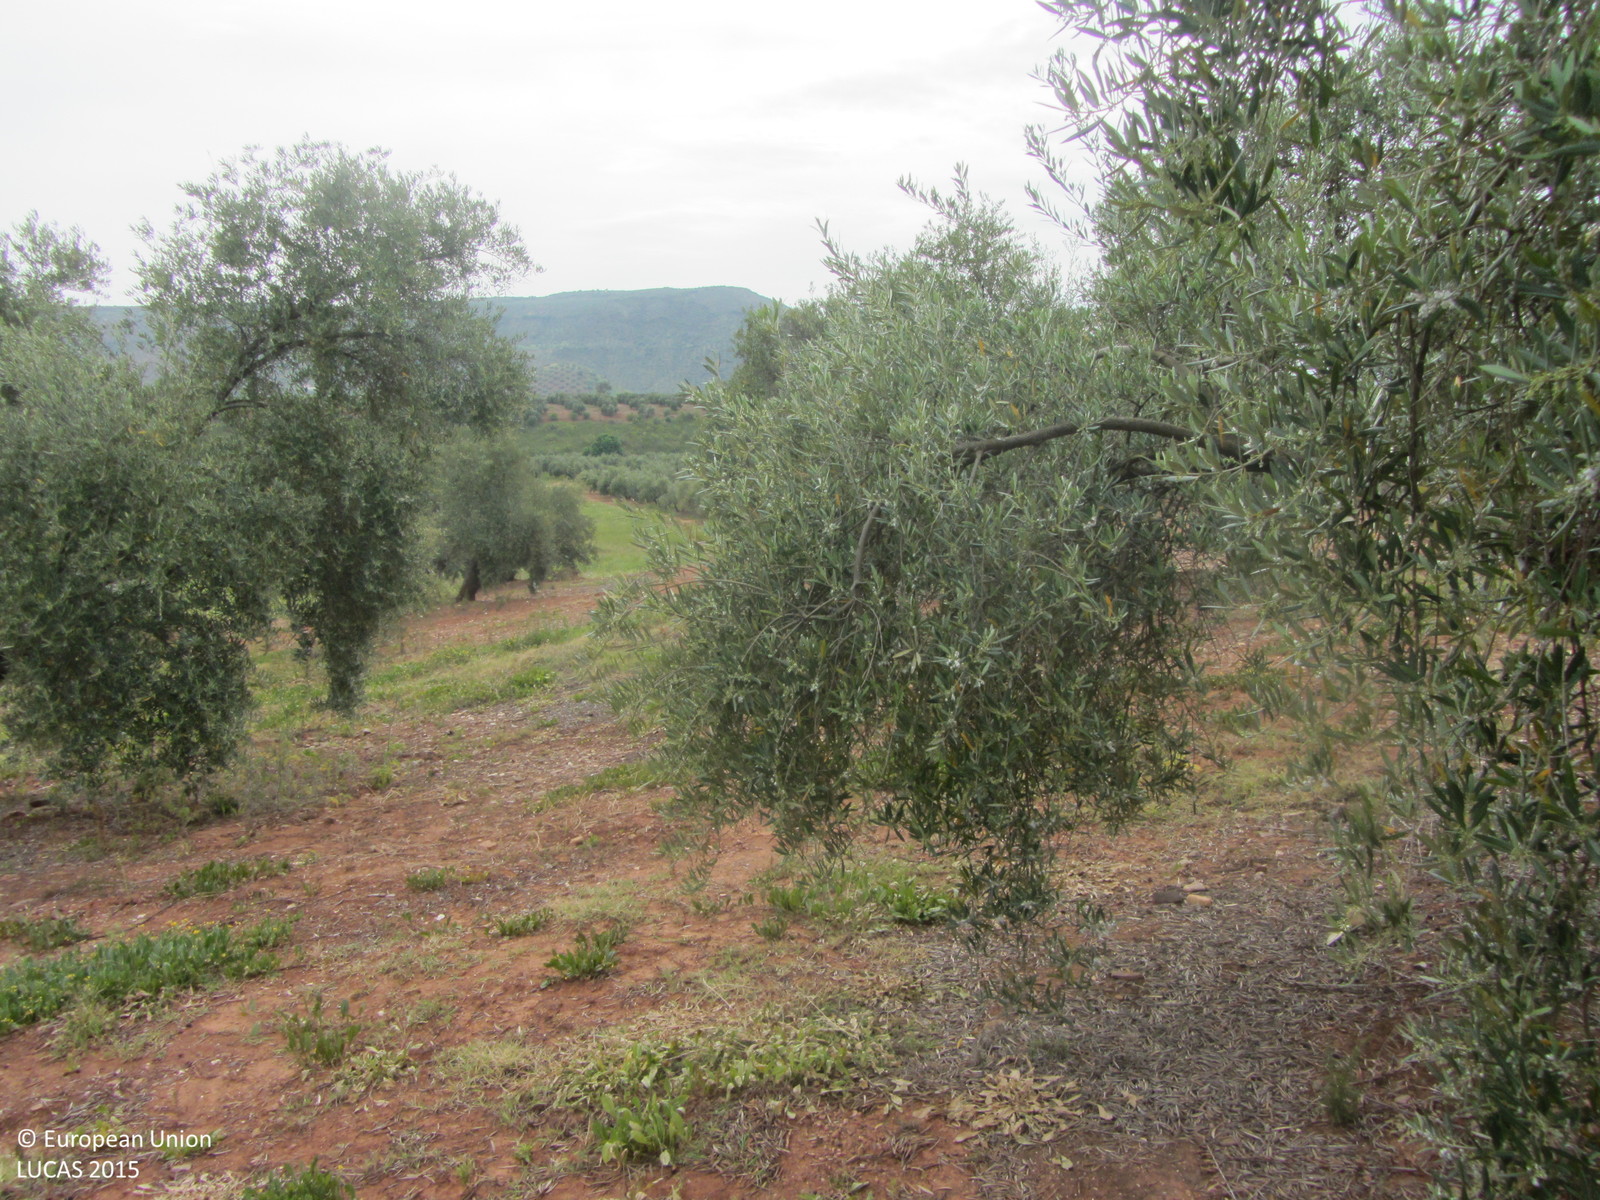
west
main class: Cropland
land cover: Olive groves
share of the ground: 25 - 50 %
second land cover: Spontaneously vegetated surfaces
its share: 50 - 75 %
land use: Agriculture (excluding fallow land and kitchen gardens)
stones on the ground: > 50 %
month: May
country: ES
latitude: 38.2636
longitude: -2.9949
